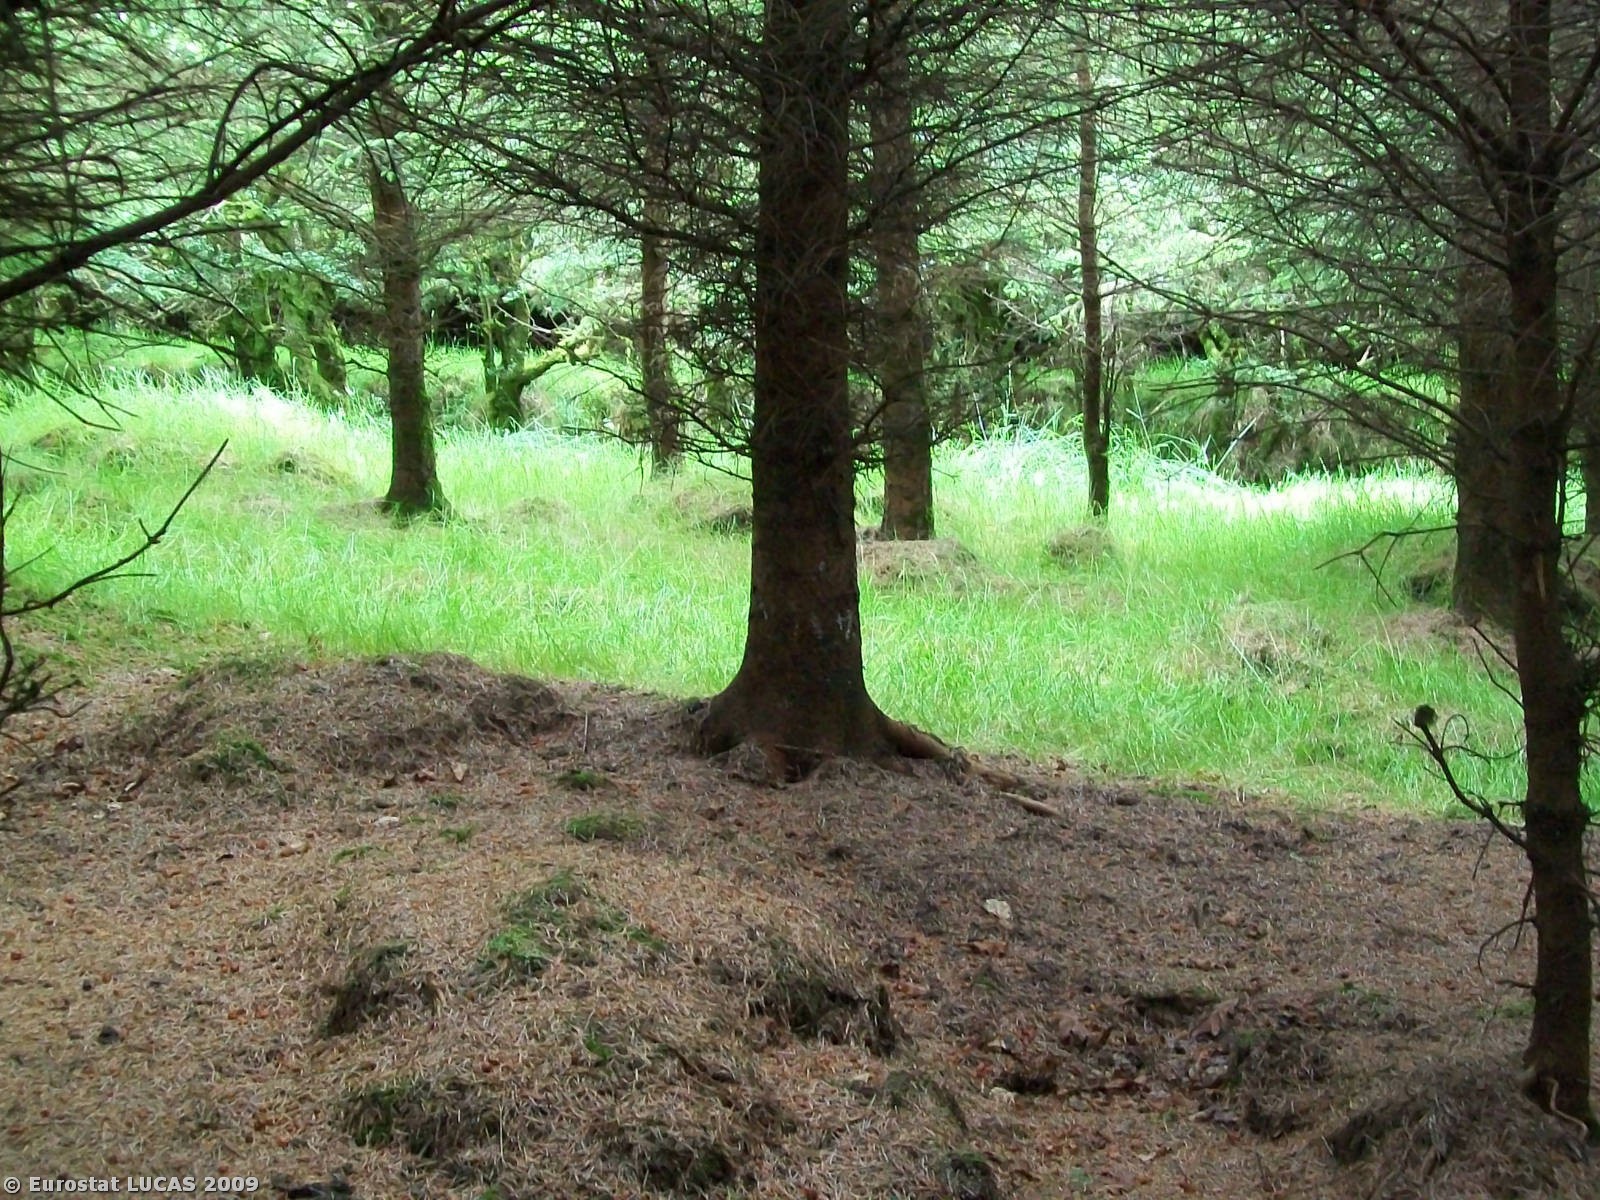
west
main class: Woodland
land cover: Coniferous woodland
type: plantations and self-sown exotic forest
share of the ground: > 75 %
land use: Forestry
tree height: > 5 m
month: July
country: GB
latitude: 54.8975
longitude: -6.8334
